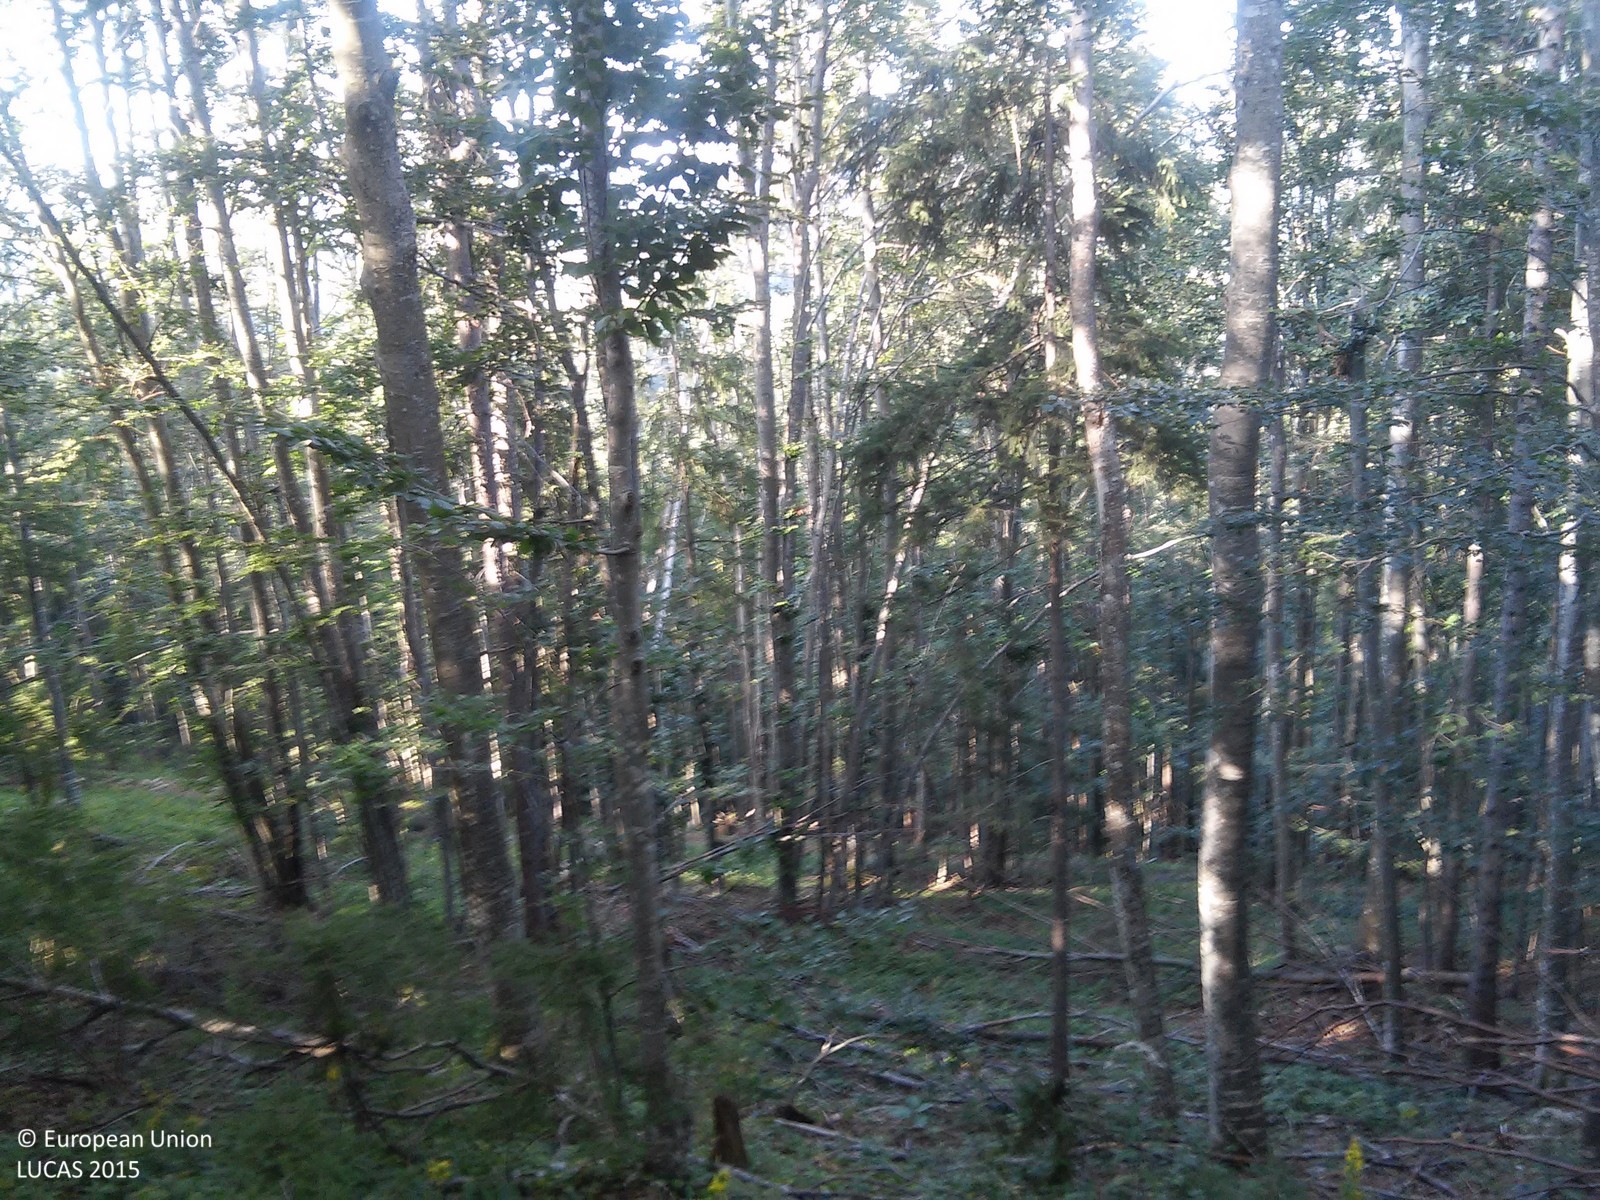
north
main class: Woodland
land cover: Other mixed woodland
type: mountainous beech forest
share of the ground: > 75 %
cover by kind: broadleaved forest trees 75 %, coniferous forest trees 25 %
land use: Forestry
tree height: > 5 m
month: September
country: HR
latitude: 45.6208
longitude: 14.5999
